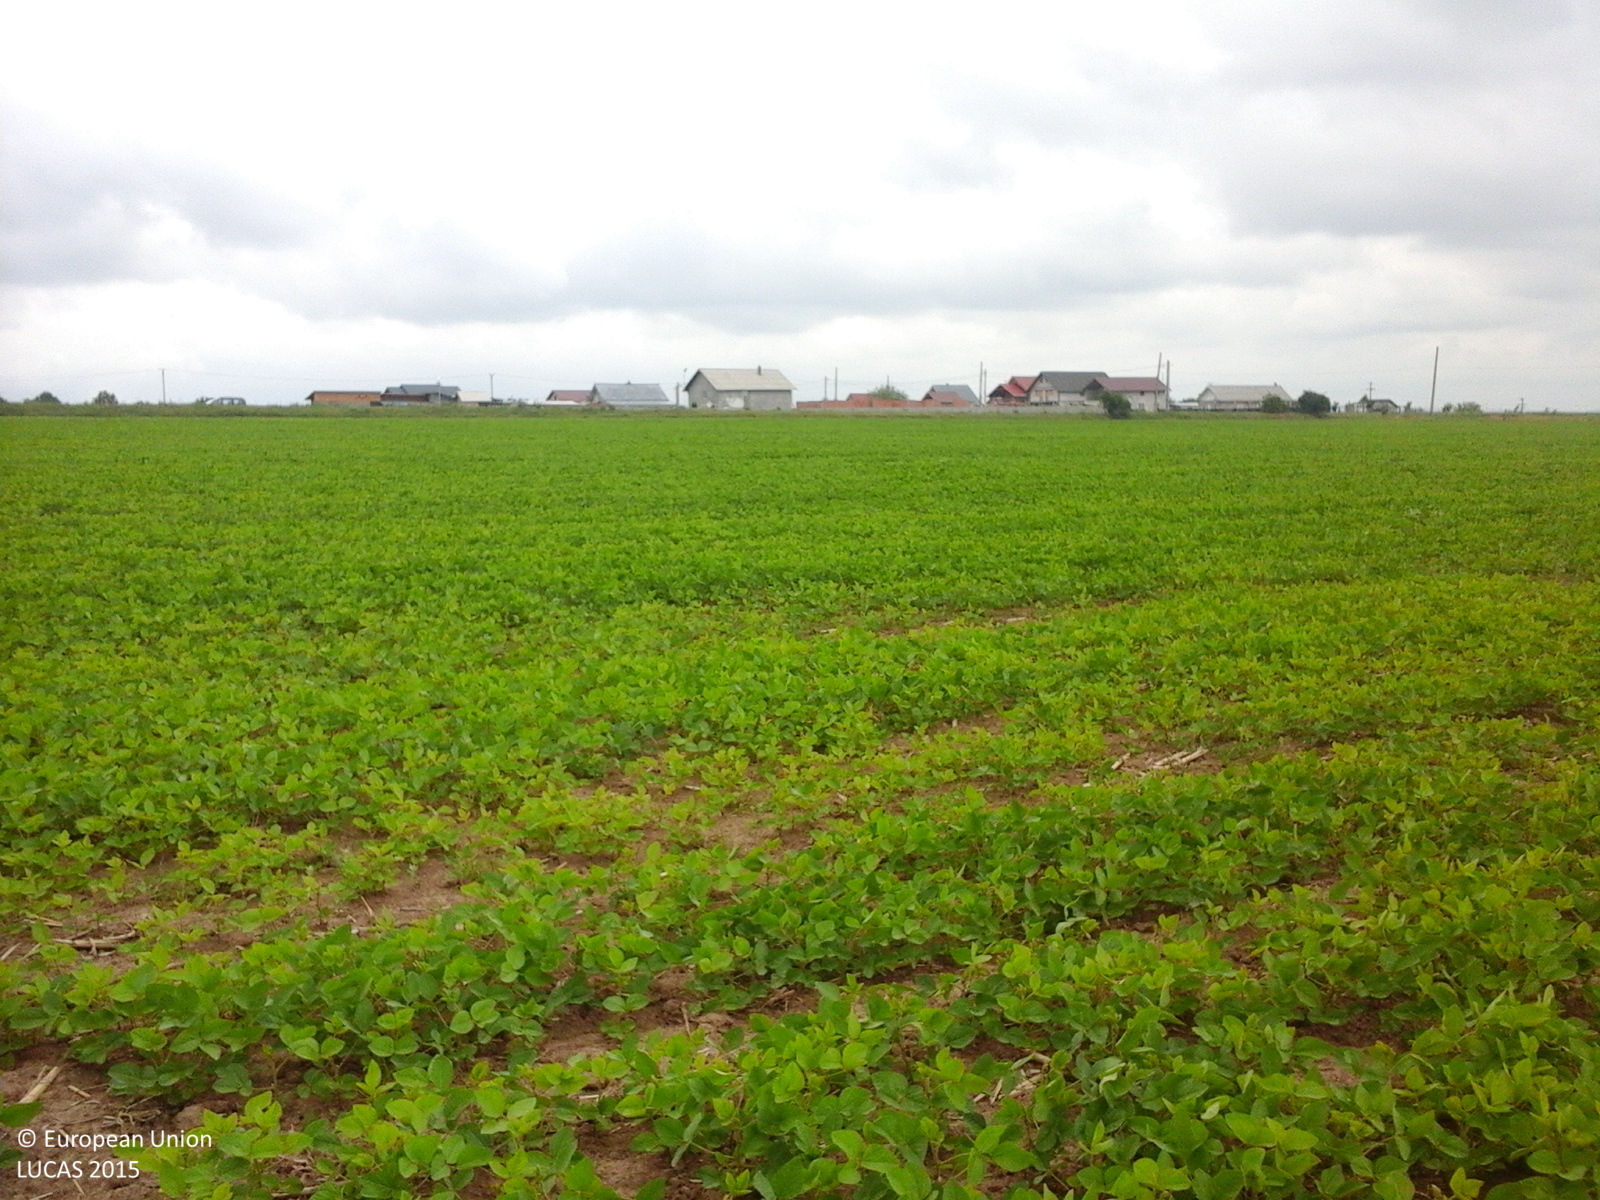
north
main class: Cropland
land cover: Soya
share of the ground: > 75 %
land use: Agriculture (excluding fallow land and kitchen gardens)
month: June
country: RO
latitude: 47.2363
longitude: 26.6696
